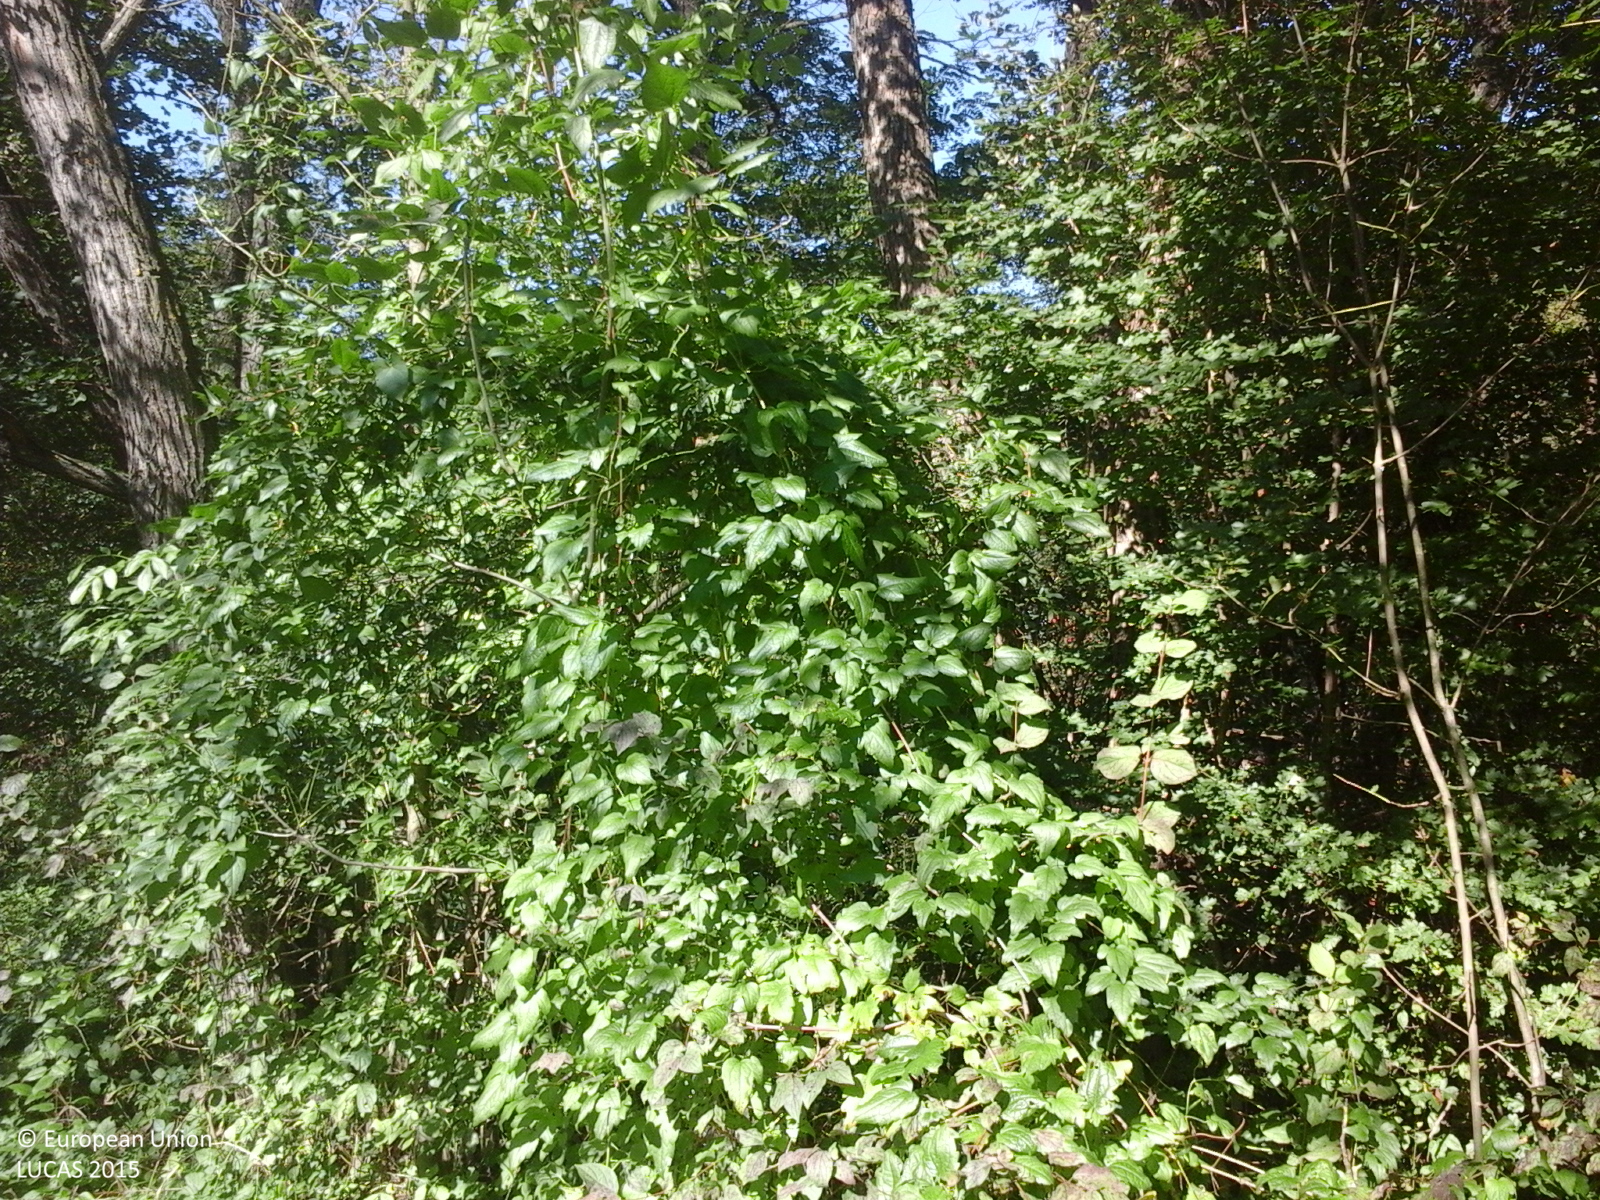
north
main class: Woodland
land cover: Broadleaved woodland
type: exotic forest
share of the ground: > 75 %
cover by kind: broadleaved forest trees 80 %, herbaceous plants 20 %
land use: Forestry
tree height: > 5 m
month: October
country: RO
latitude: 46.5120
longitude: 23.5050
